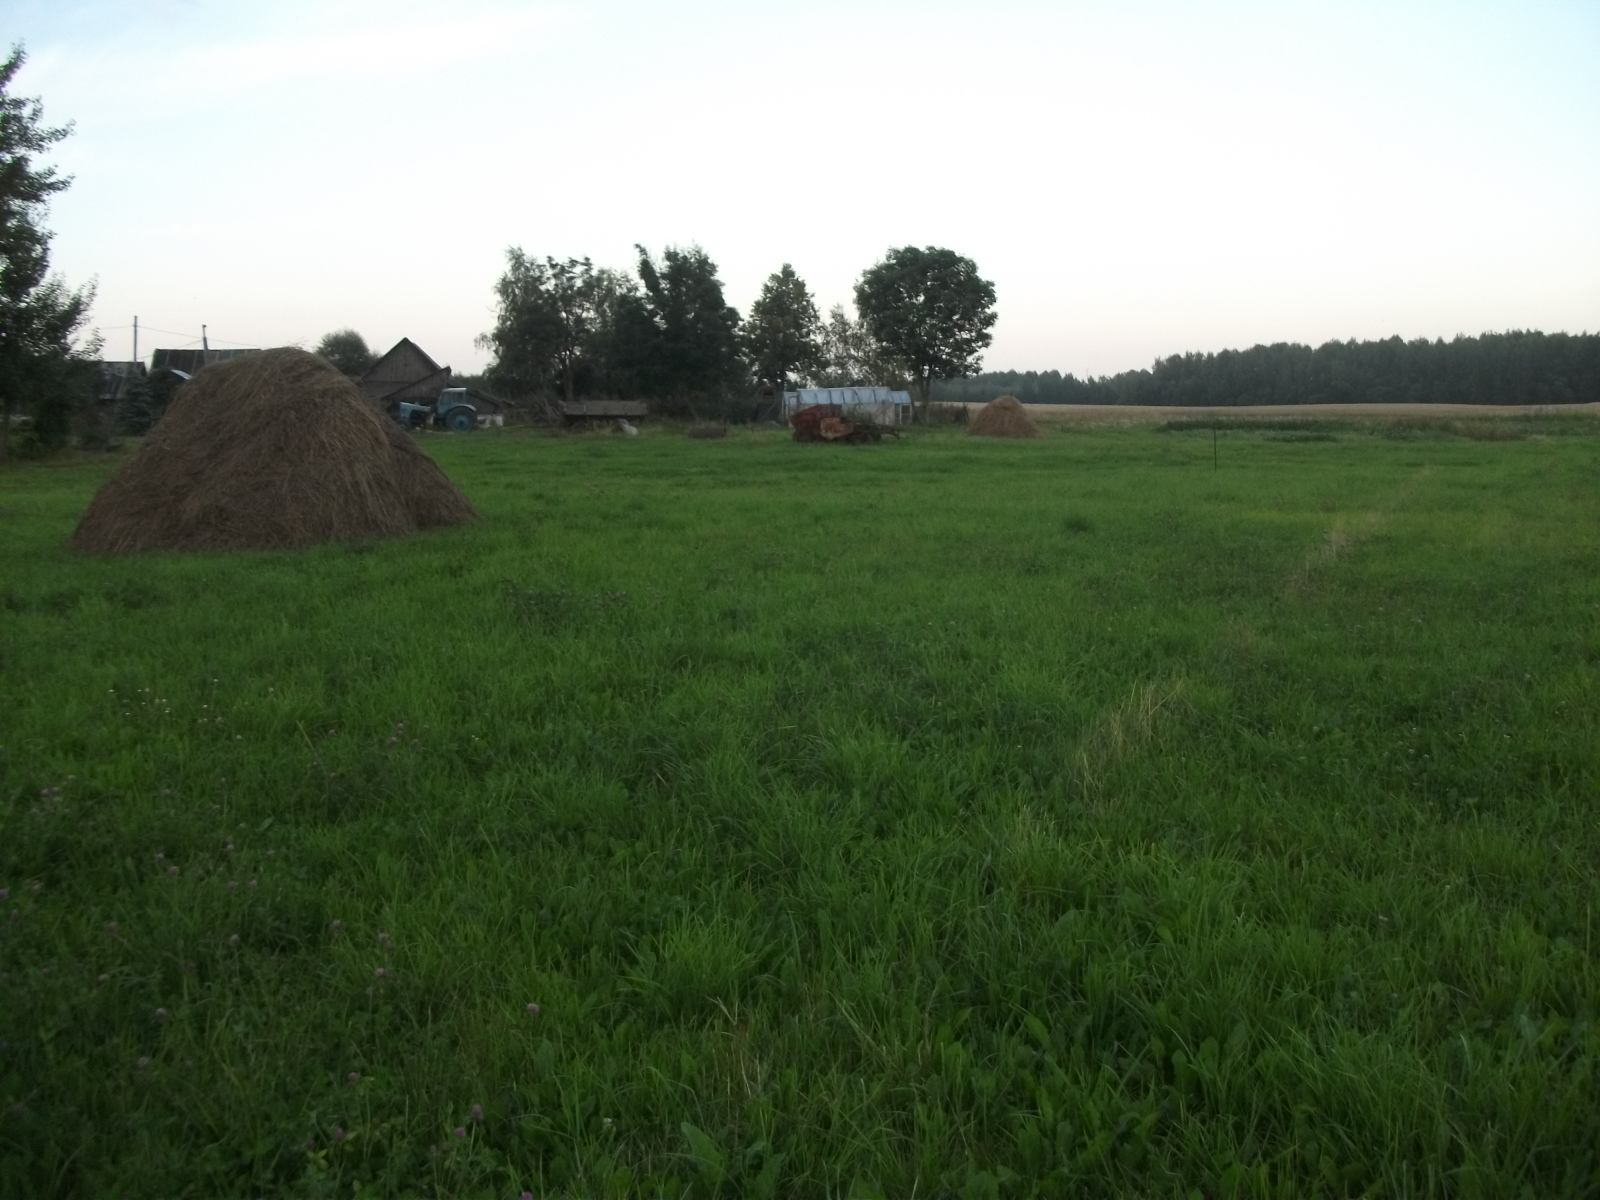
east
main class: Grassland
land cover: Grassland without tree/shrub cover
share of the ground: > 75 %
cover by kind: herbaceous plants 100 %
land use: Agriculture (excluding fallow land and kitchen gardens)
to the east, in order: Grassland without tree/shrub cover; Artificial constructions in urban areas; Other bare soil; Common wheat
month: August
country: LV
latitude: 56.7446
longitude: 26.5142
